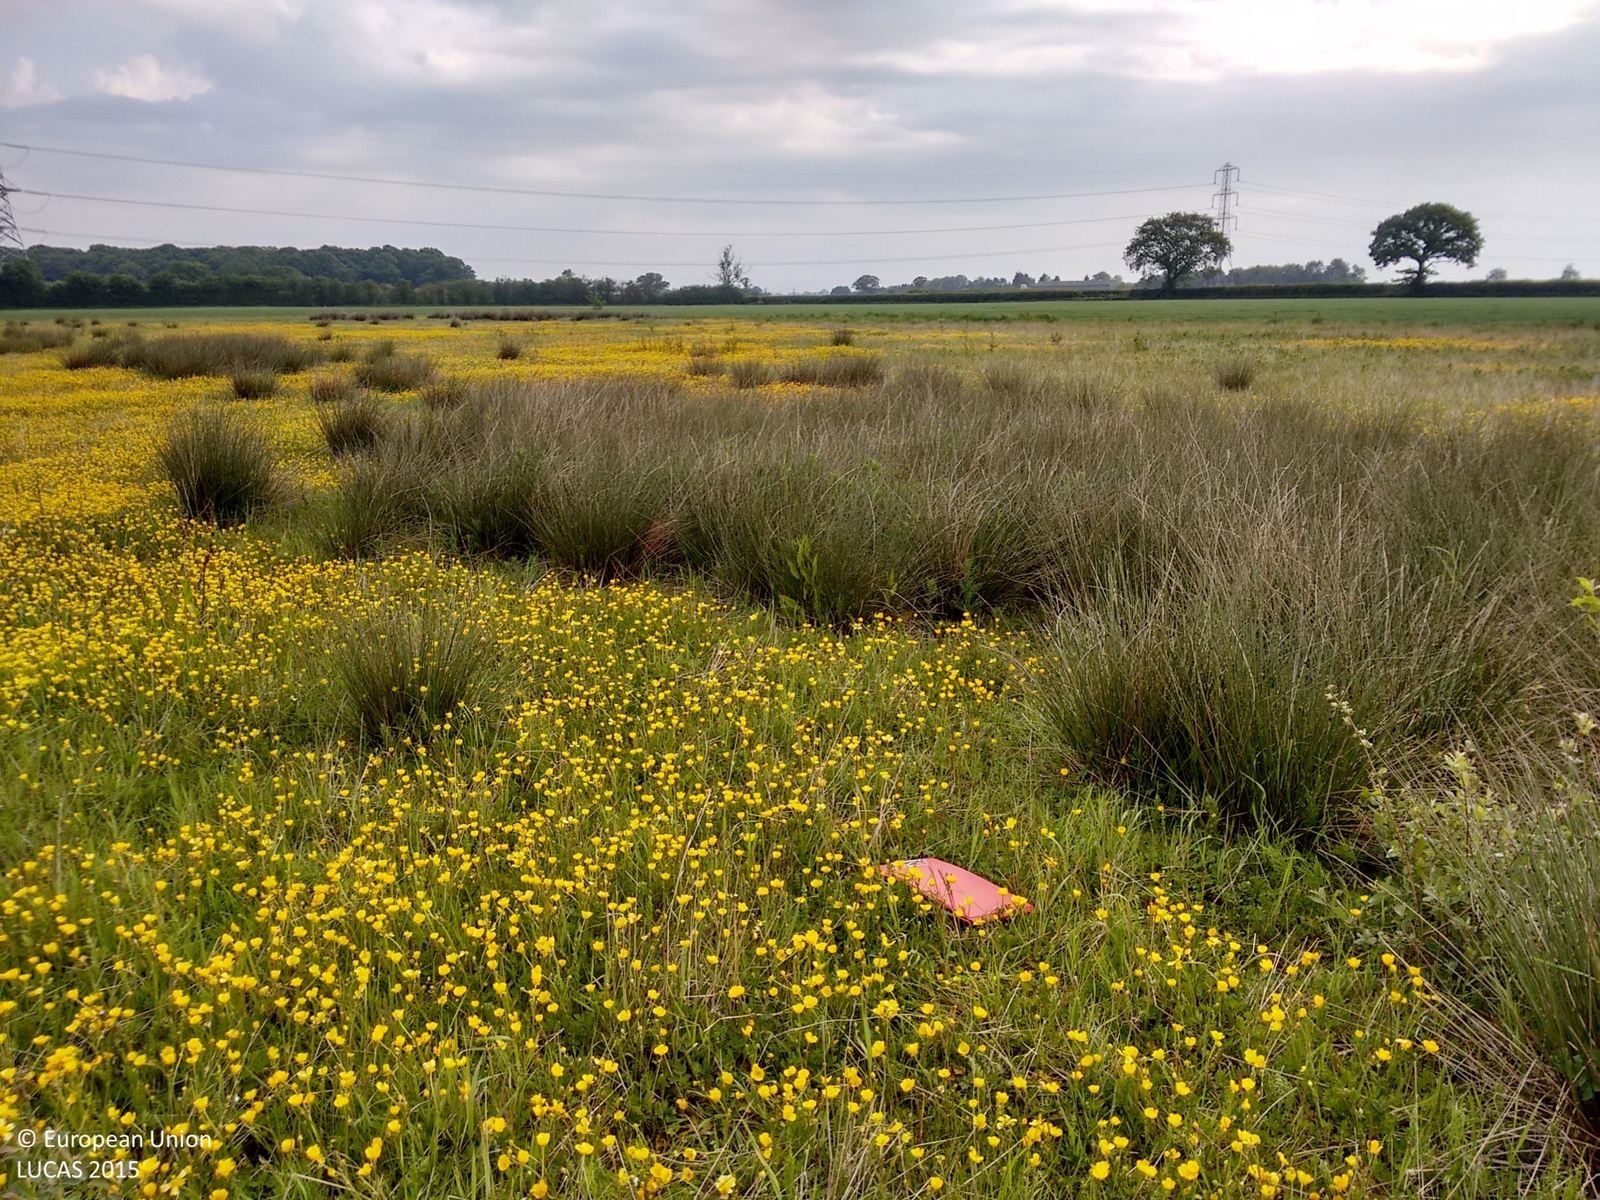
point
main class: Grassland
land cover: Spontaneously vegetated surfaces
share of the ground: > 75 %
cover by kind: herbaceous plants 95 %, shrubs 5 %
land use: Fallow land
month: June
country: GB
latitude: 54.0298
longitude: -1.1432
